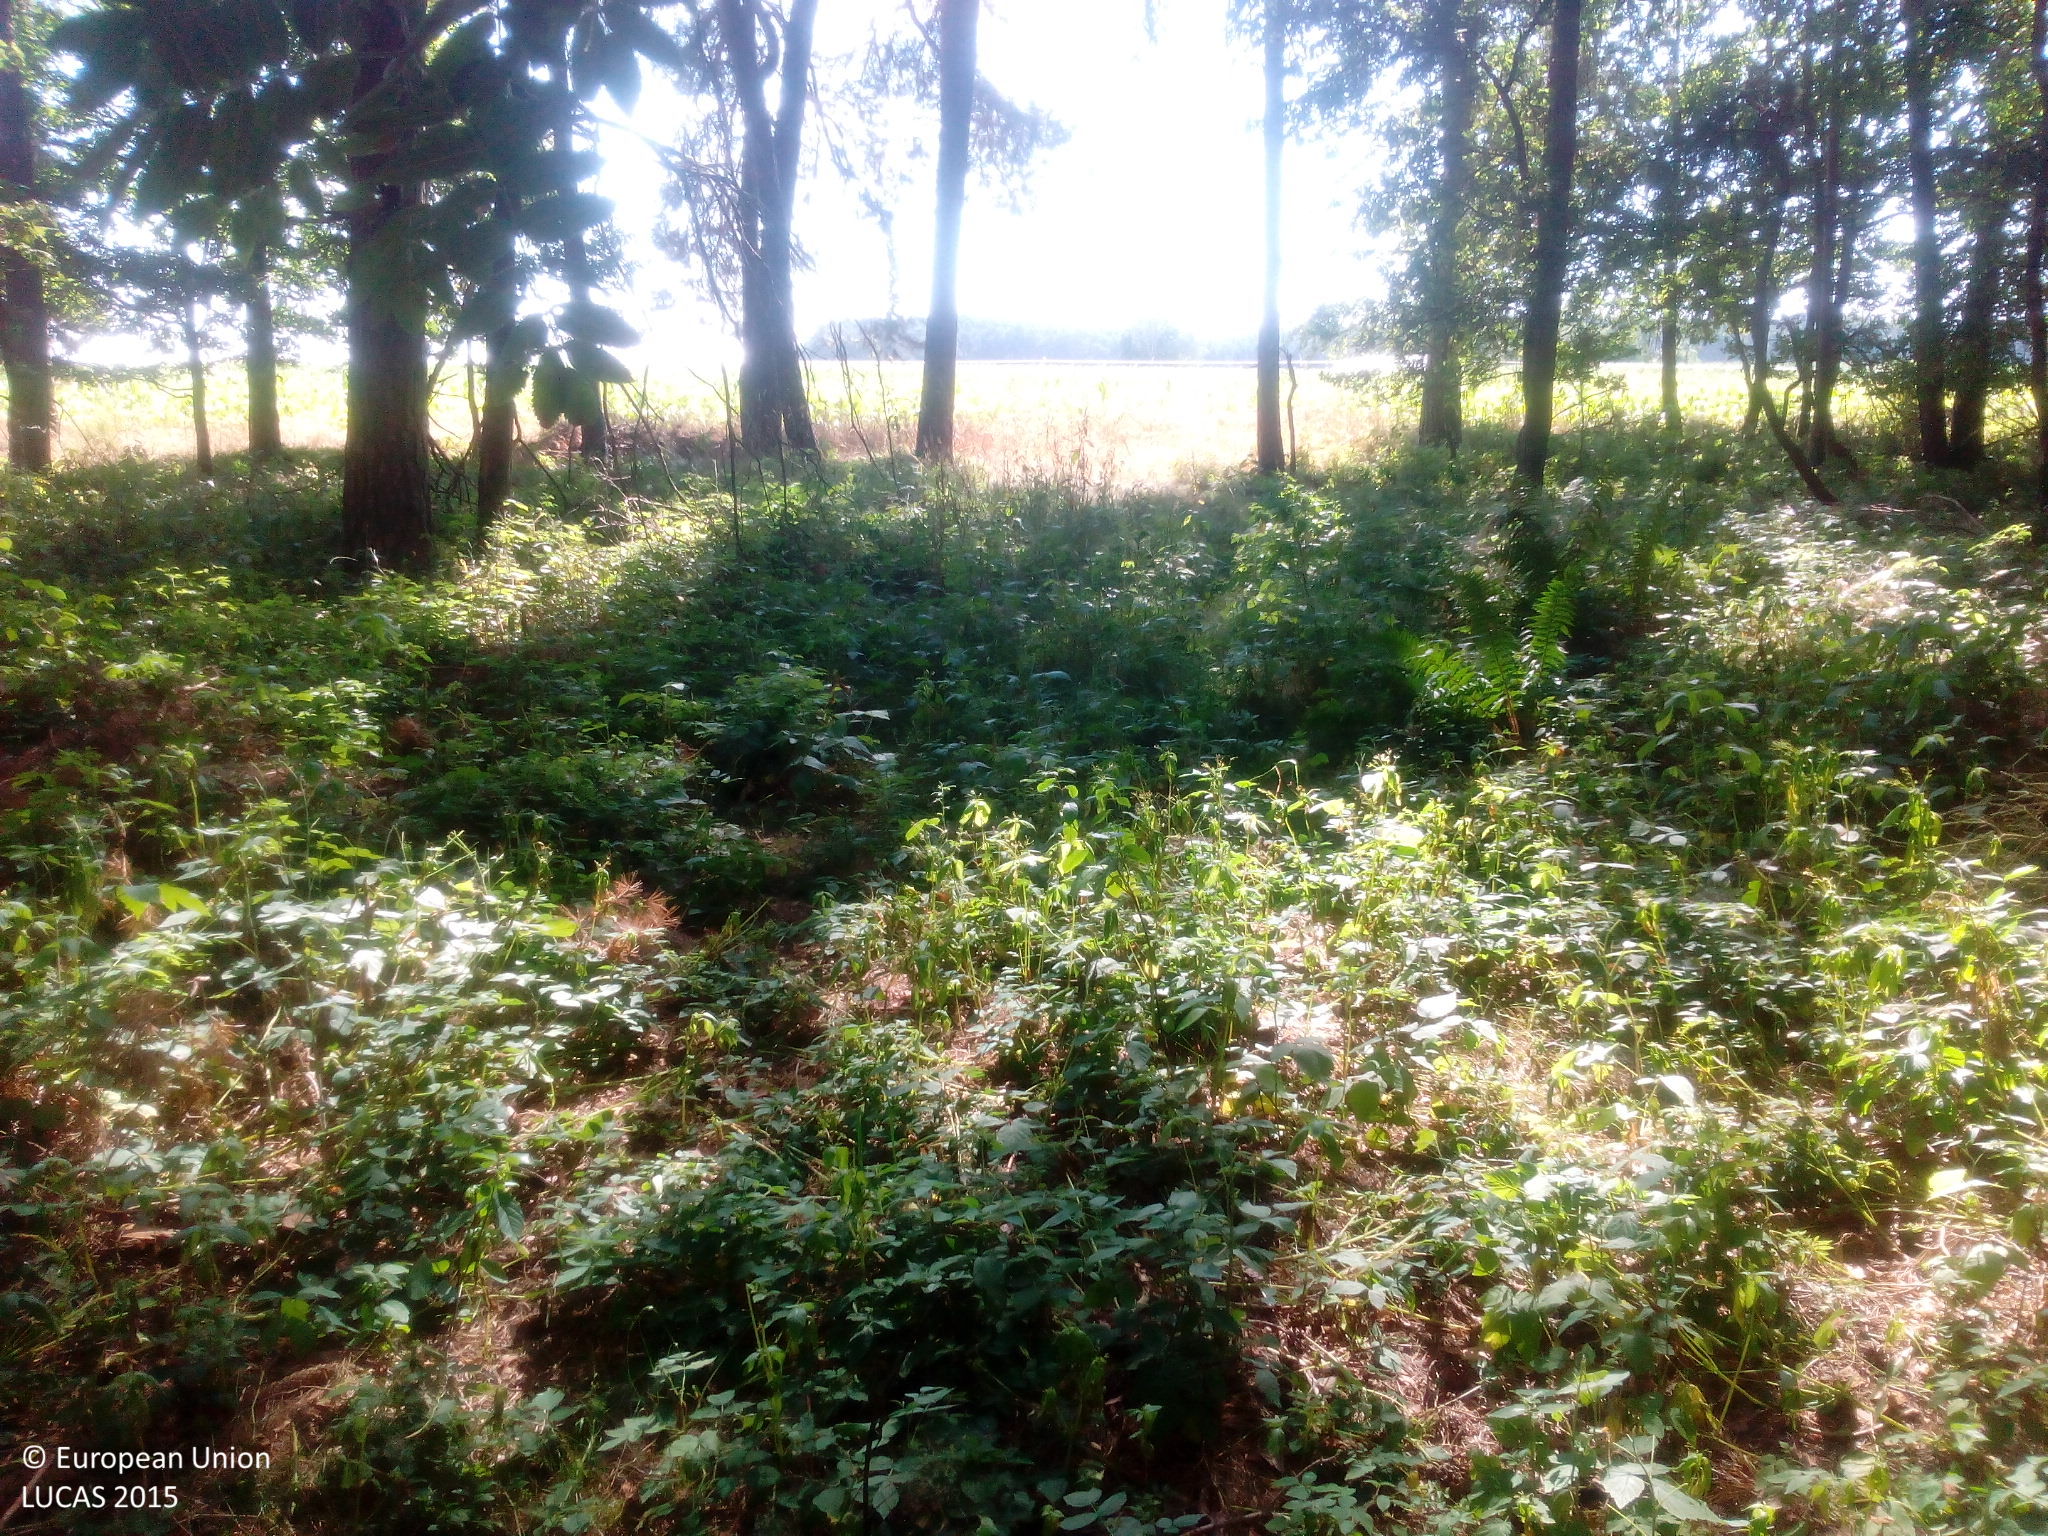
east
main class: Woodland
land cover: Other mixed woodland
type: hemiboreal forest and nemoral coniferous forest and mixed broadleaved-coniferous forest
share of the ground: > 75 %
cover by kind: coniferous forest trees 60 %, broadleaved forest trees 25 %, herbaceous plants 15 %
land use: Forestry
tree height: > 5 m
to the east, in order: Other mixed woodland; Grass margins; Fences; Tobacco; Fences; Potatoes
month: July
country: DE
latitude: 49.3352
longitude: 10.9217
